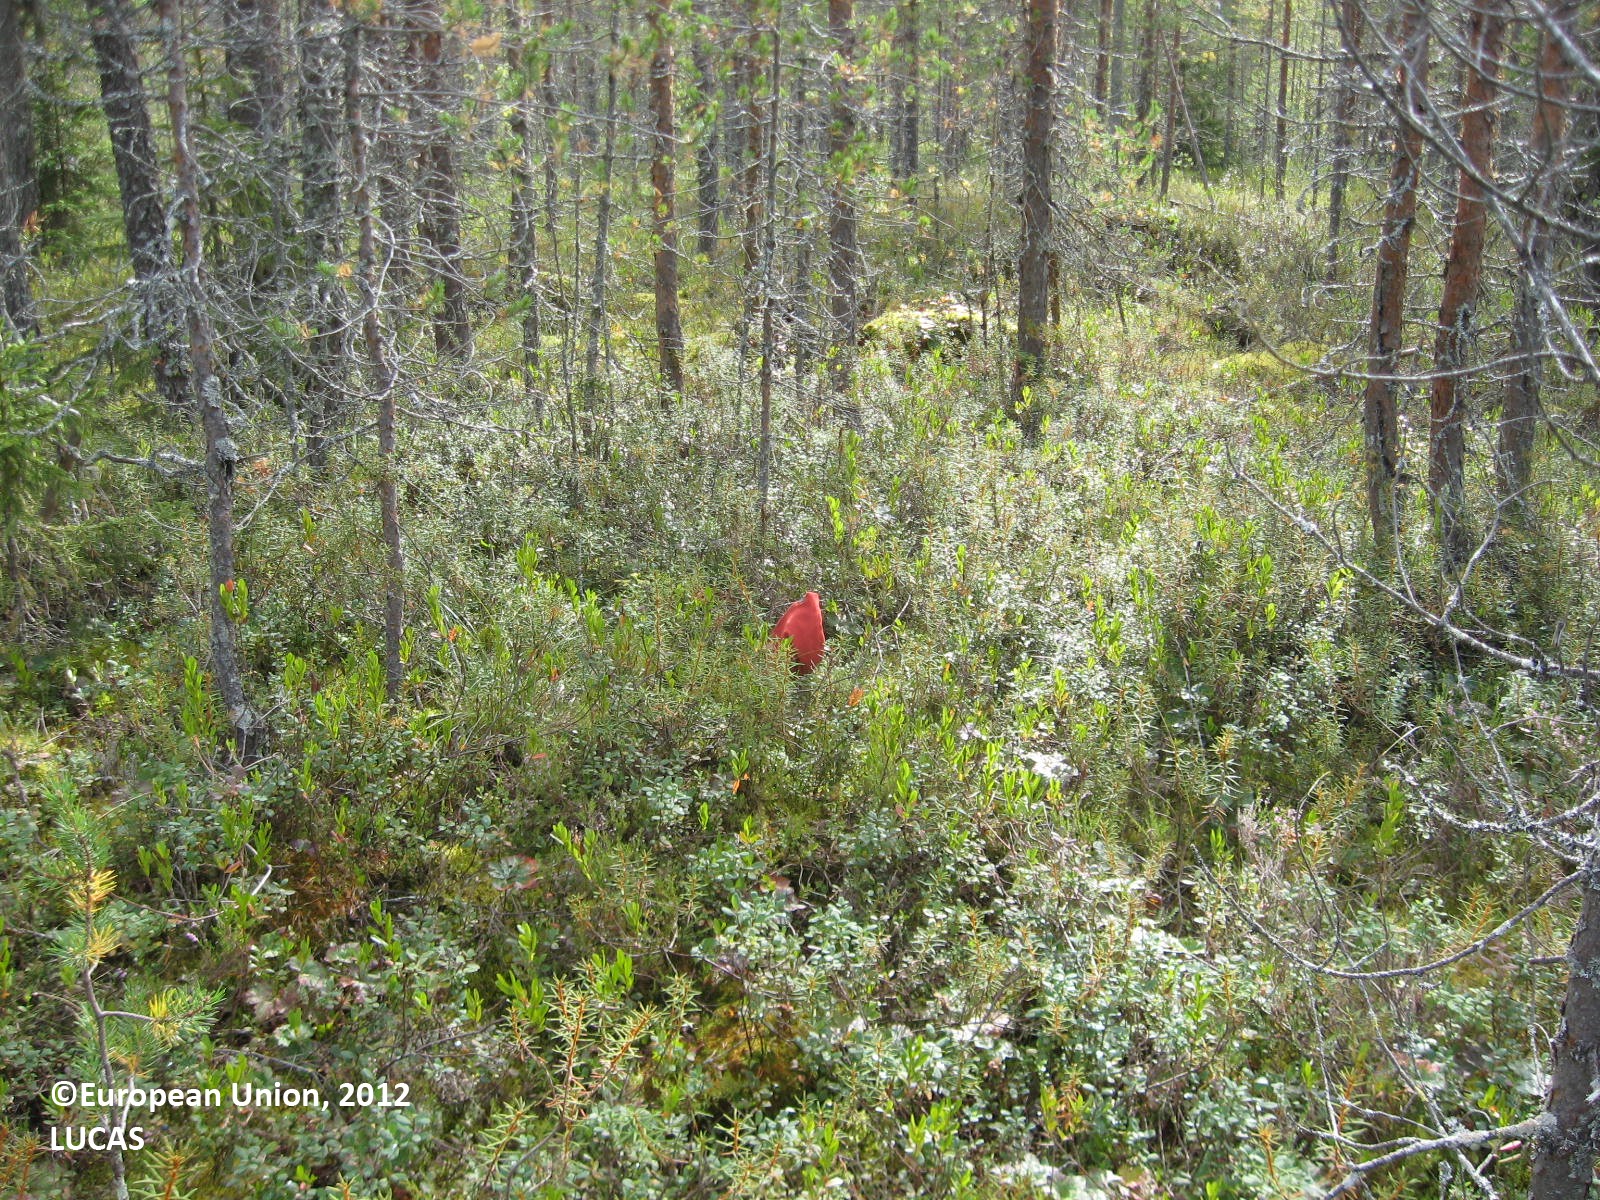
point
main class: Woodland
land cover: Pine dominated coniferous woodland
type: boreal forest
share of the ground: 50 - 75 %
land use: Forestry
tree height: > 5 m
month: August
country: FI
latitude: 63.6654
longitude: 29.5634
